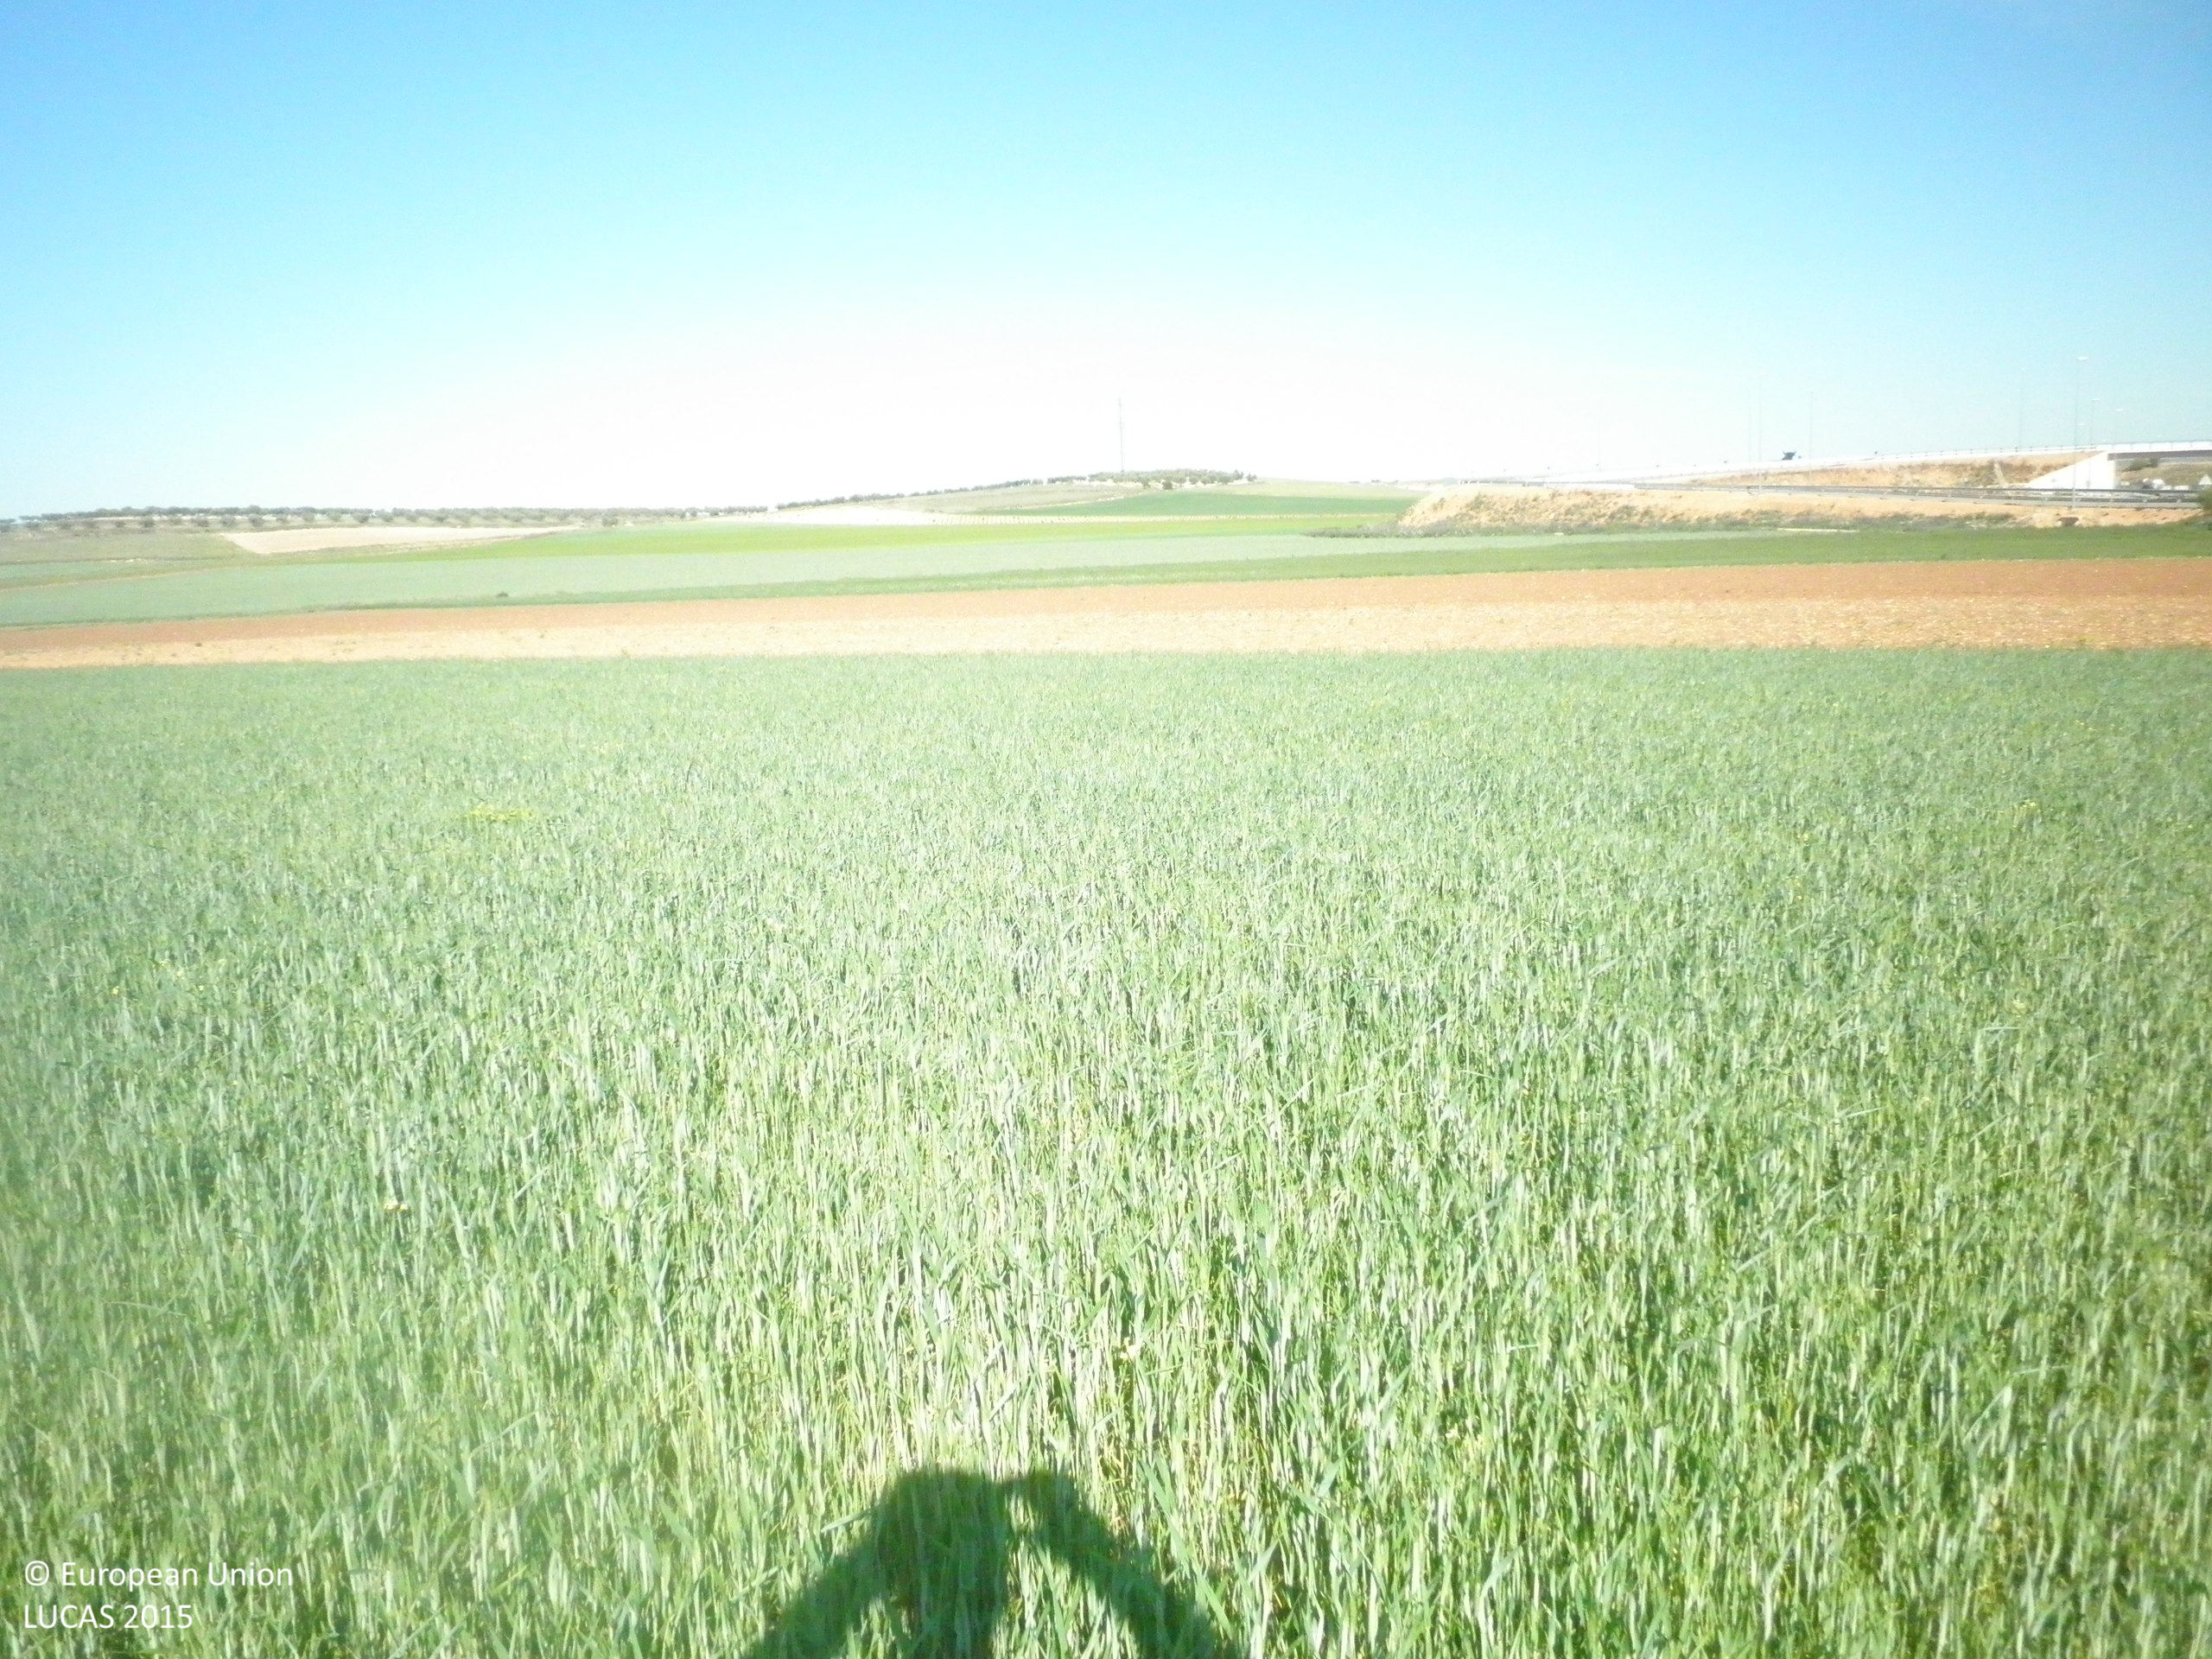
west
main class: Cropland
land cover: Durum wheat
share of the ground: > 75 %
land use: Agriculture (excluding fallow land and kitchen gardens)
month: May
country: ES
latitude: 39.4724
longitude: -2.7193
